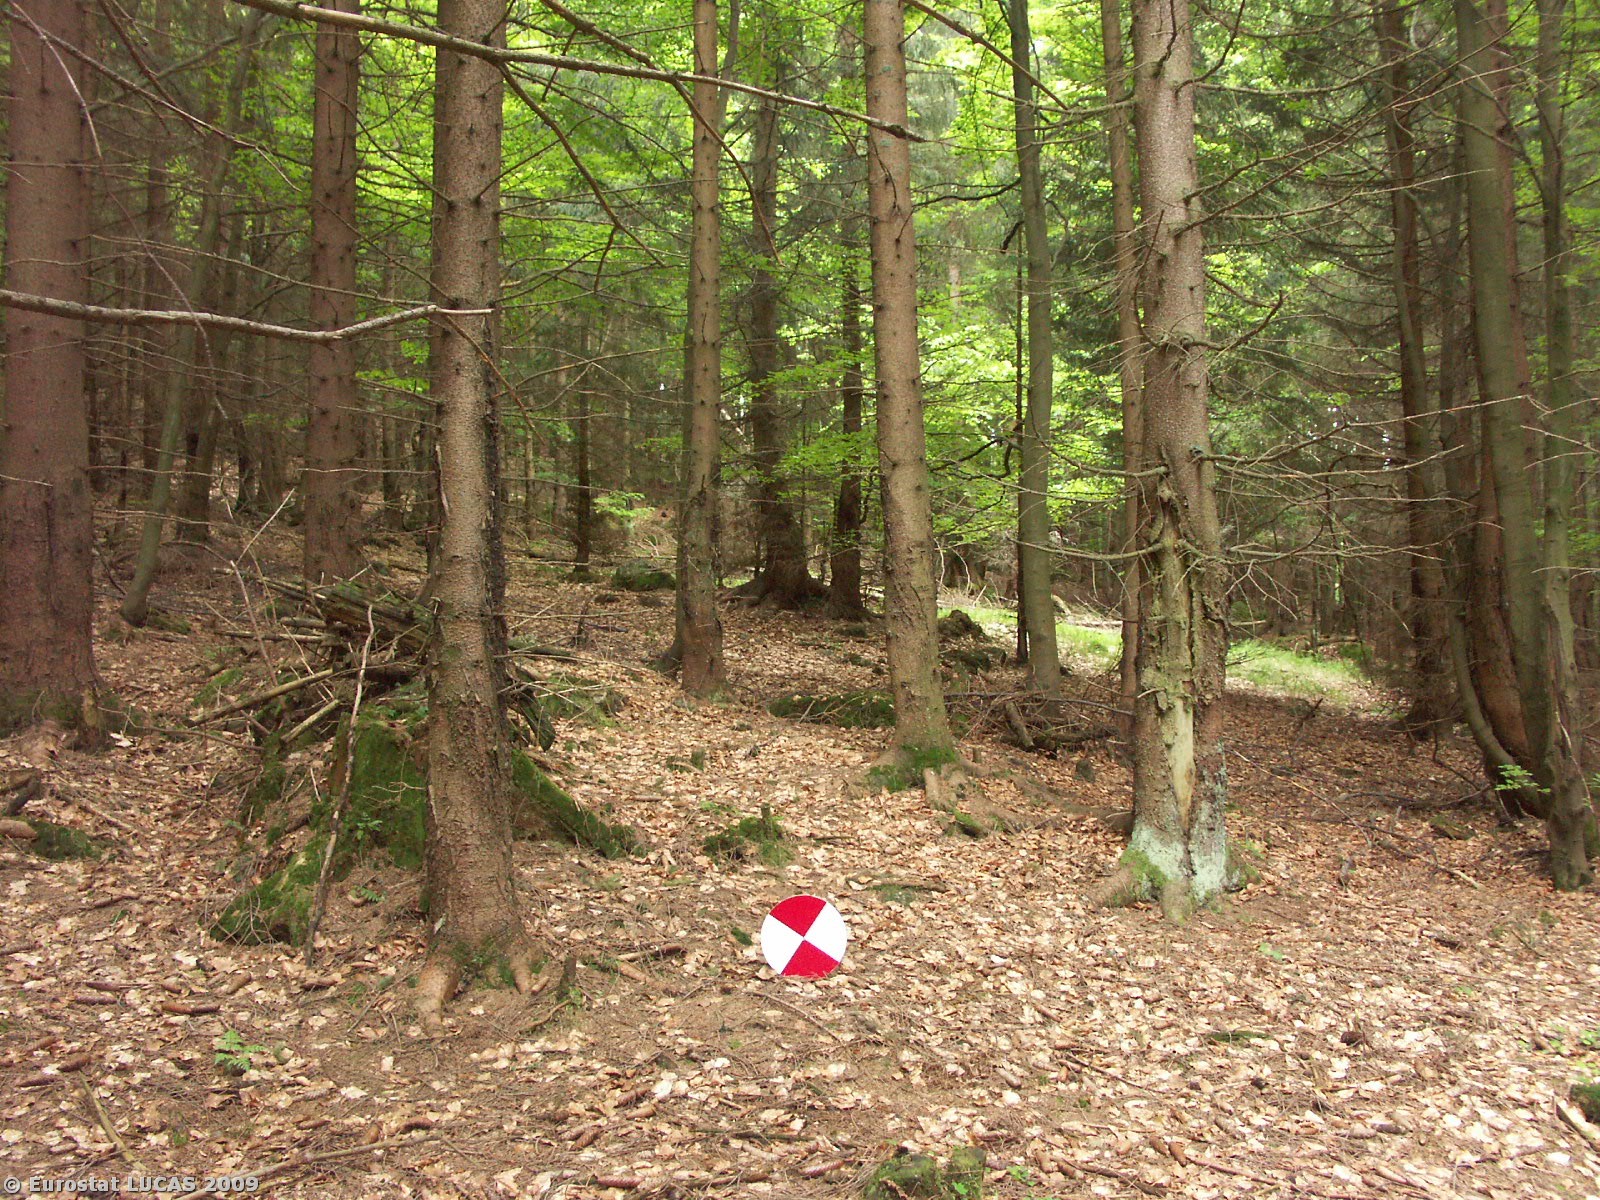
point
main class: Woodland
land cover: Mixed woodland
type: mountainous beech forest
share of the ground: > 75 %
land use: Forestry
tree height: > 5 m
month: May
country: CZ
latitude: 48.6120
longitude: 14.6534
